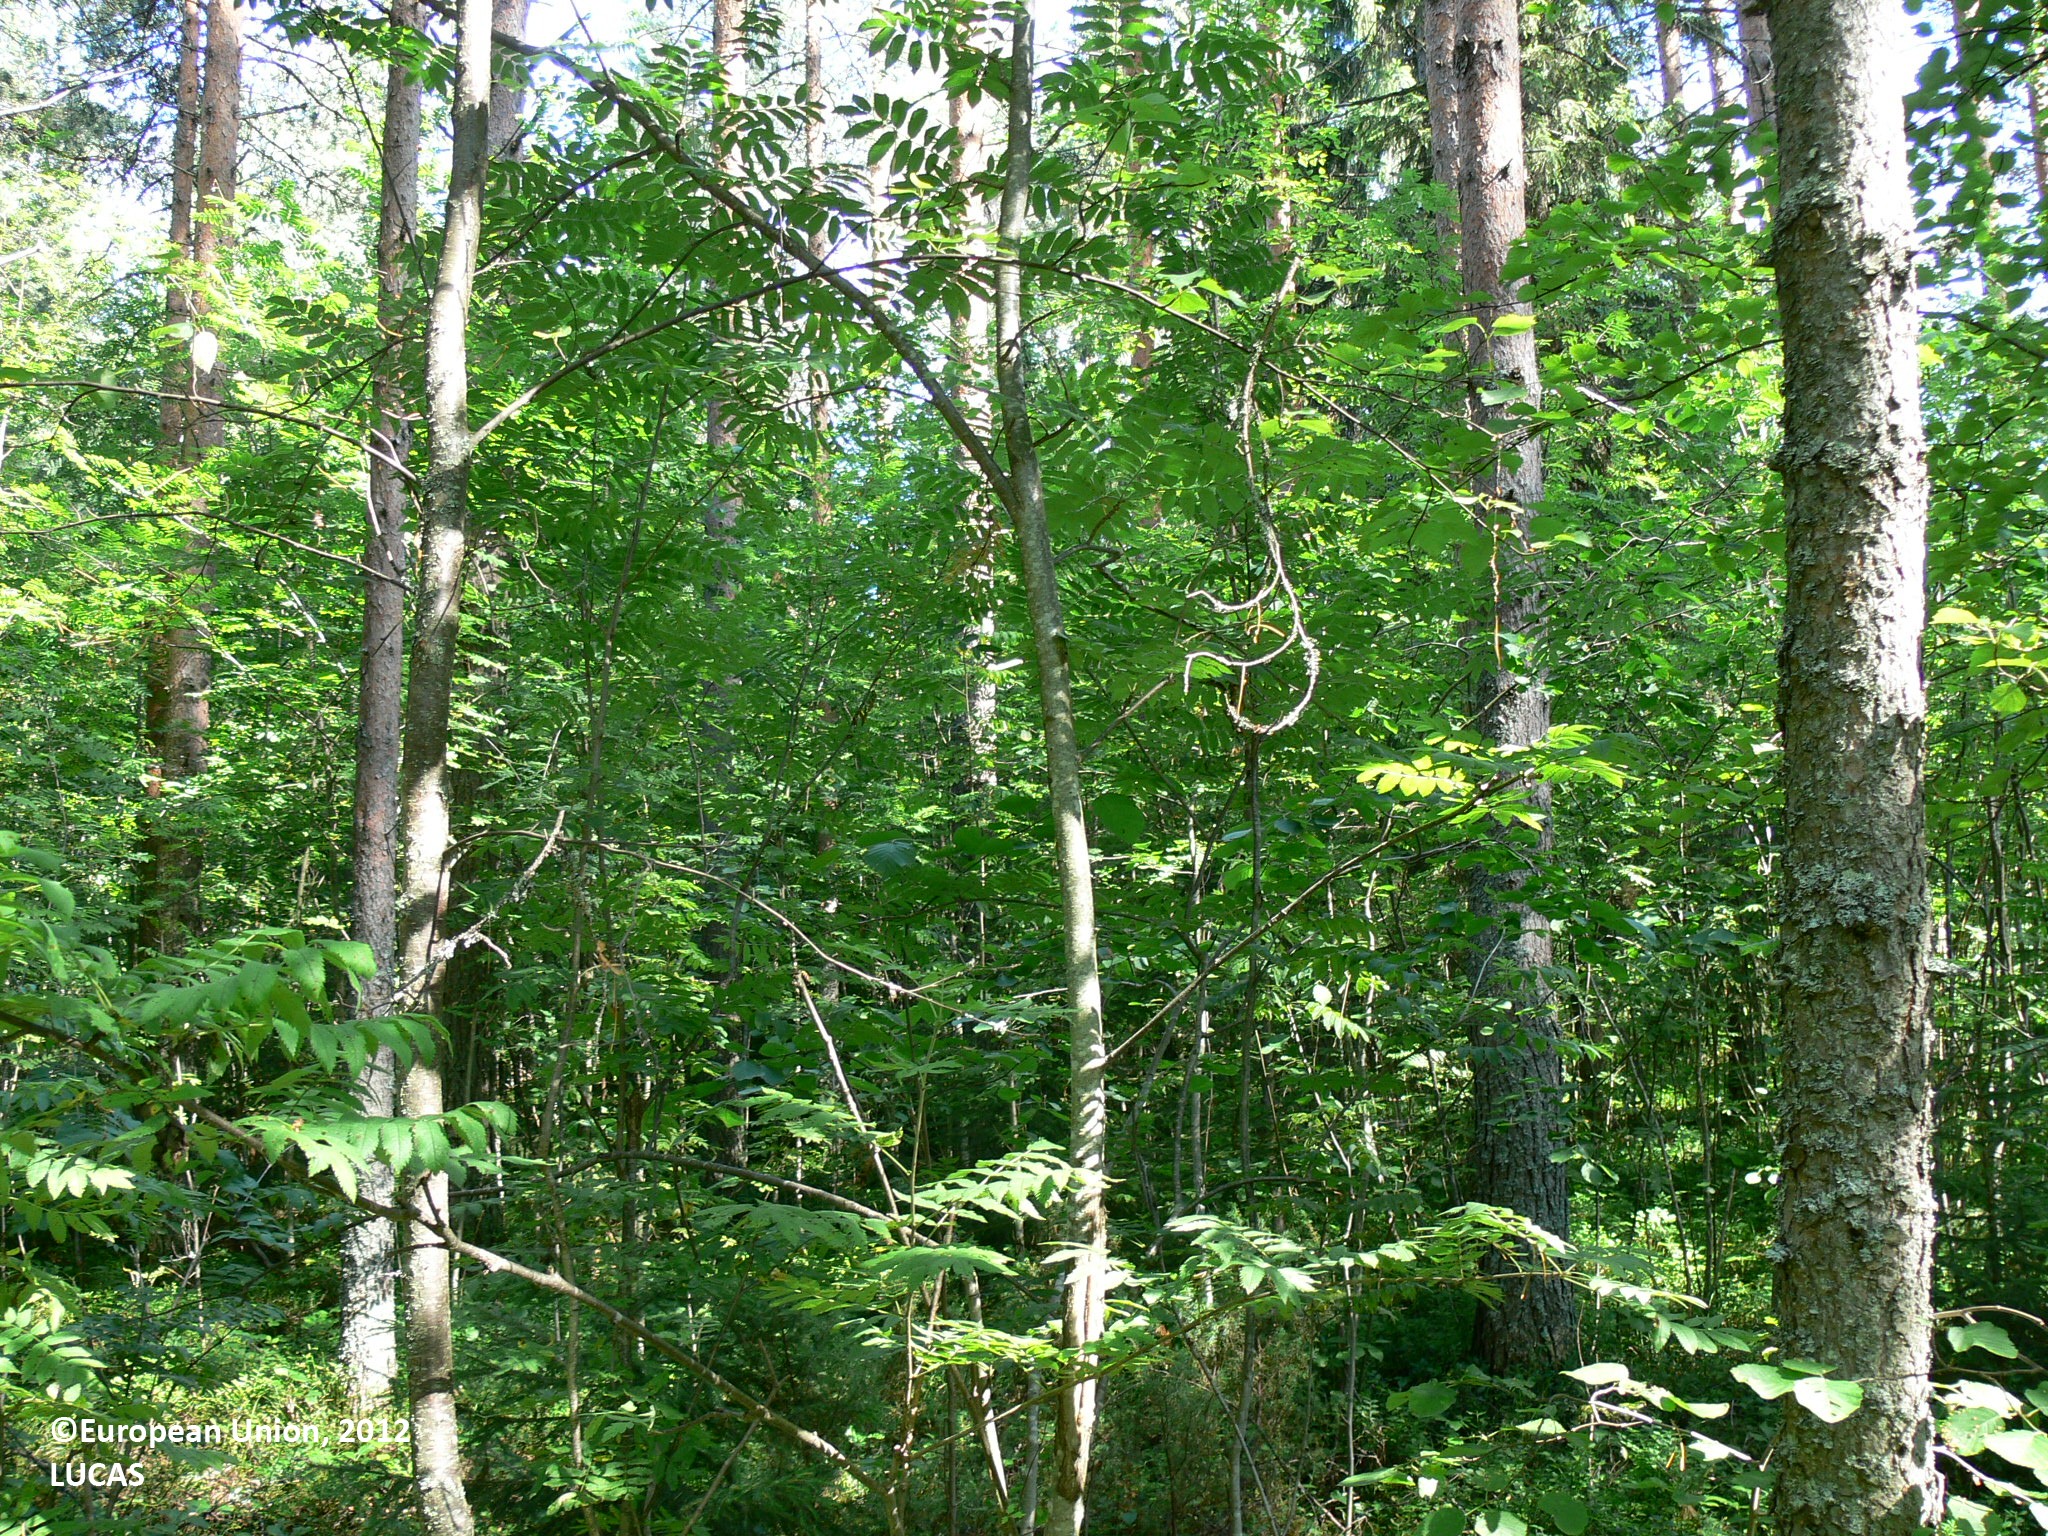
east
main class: Woodland
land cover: Pine dominated mixed woodland
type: boreal forest
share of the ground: > 75 %
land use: Forestry
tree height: > 5 m
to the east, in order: Pine dominated mixed woodland; Tracks; Other mixed woodland; Grass margins; Ditches and canals; Grass margins; Paved roads, cycling and walking lanes; Grass margins; Other coniferous woodland; Other bare soil; Electric lines; Other bare soil; Spruce dominated coniferous woodland
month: July
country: FI
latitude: 63.3284
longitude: 29.4154
